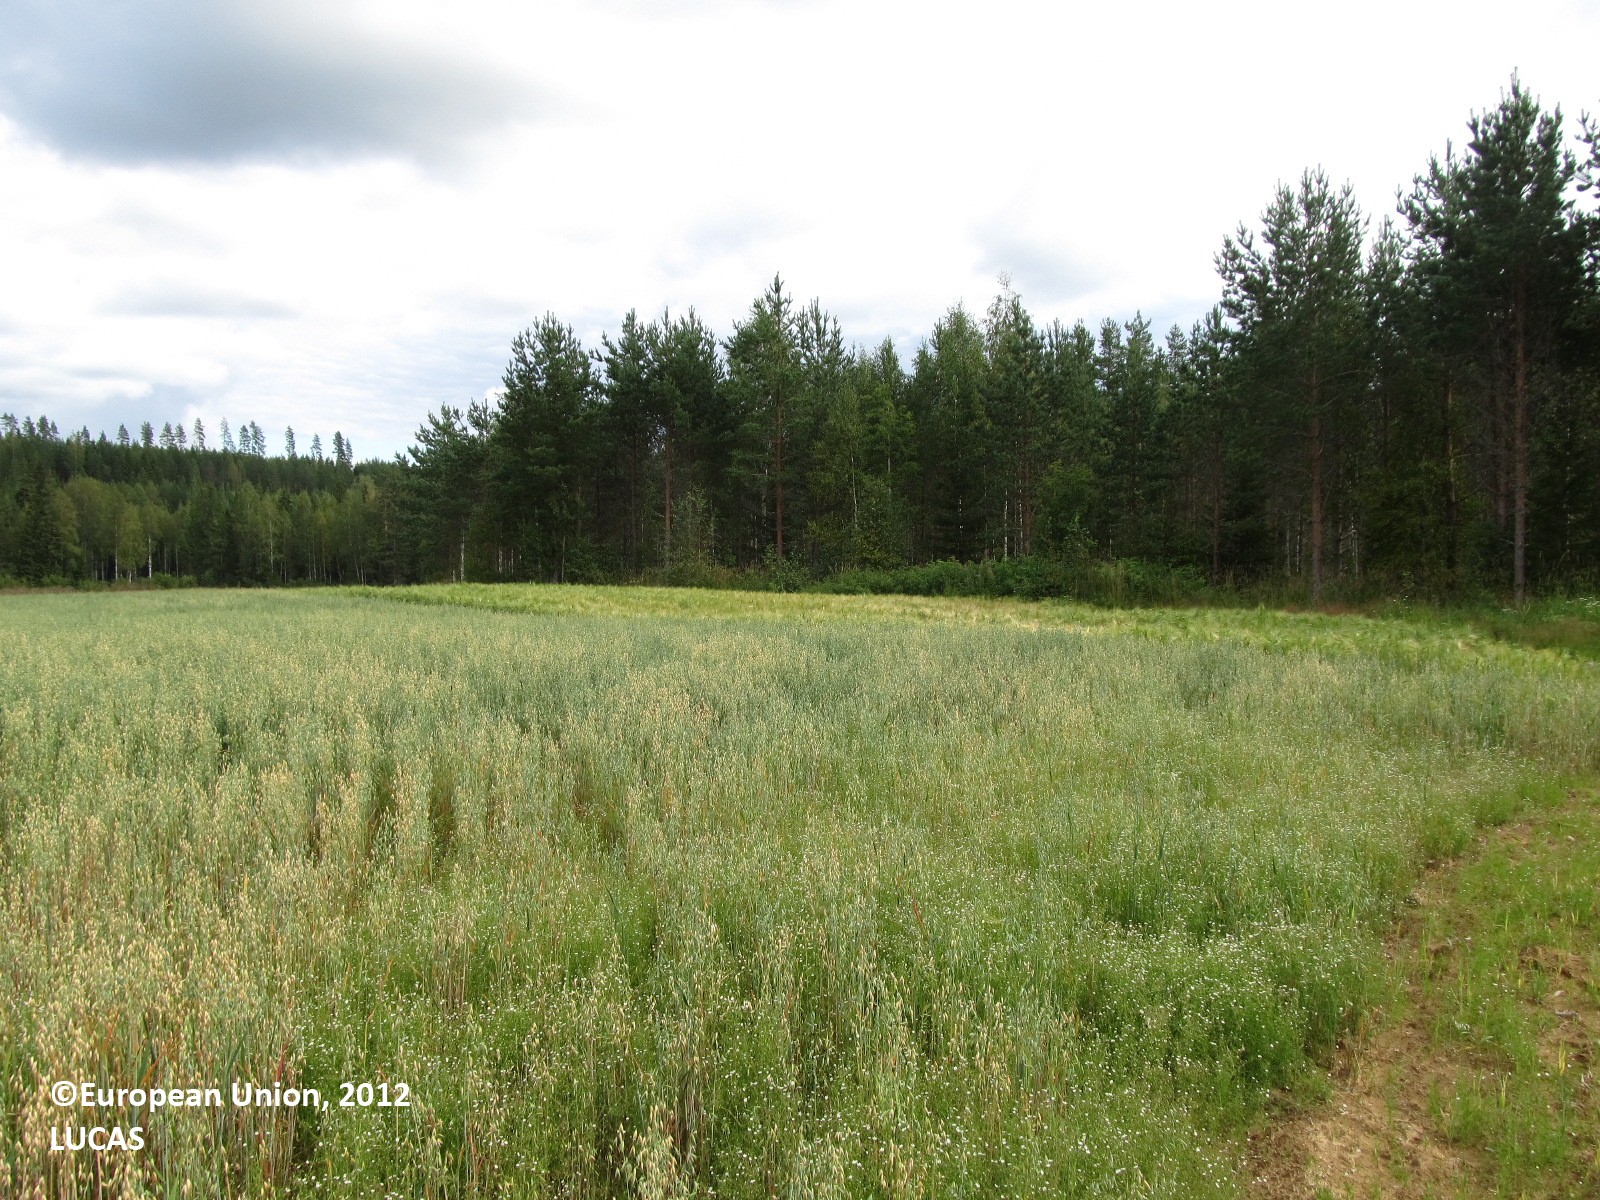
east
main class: Cropland
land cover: Oats
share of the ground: > 75 %
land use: Agriculture (excluding fallow land and kitchen gardens)
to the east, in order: Oats
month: August
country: FI
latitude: 62.3346
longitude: 28.5652
